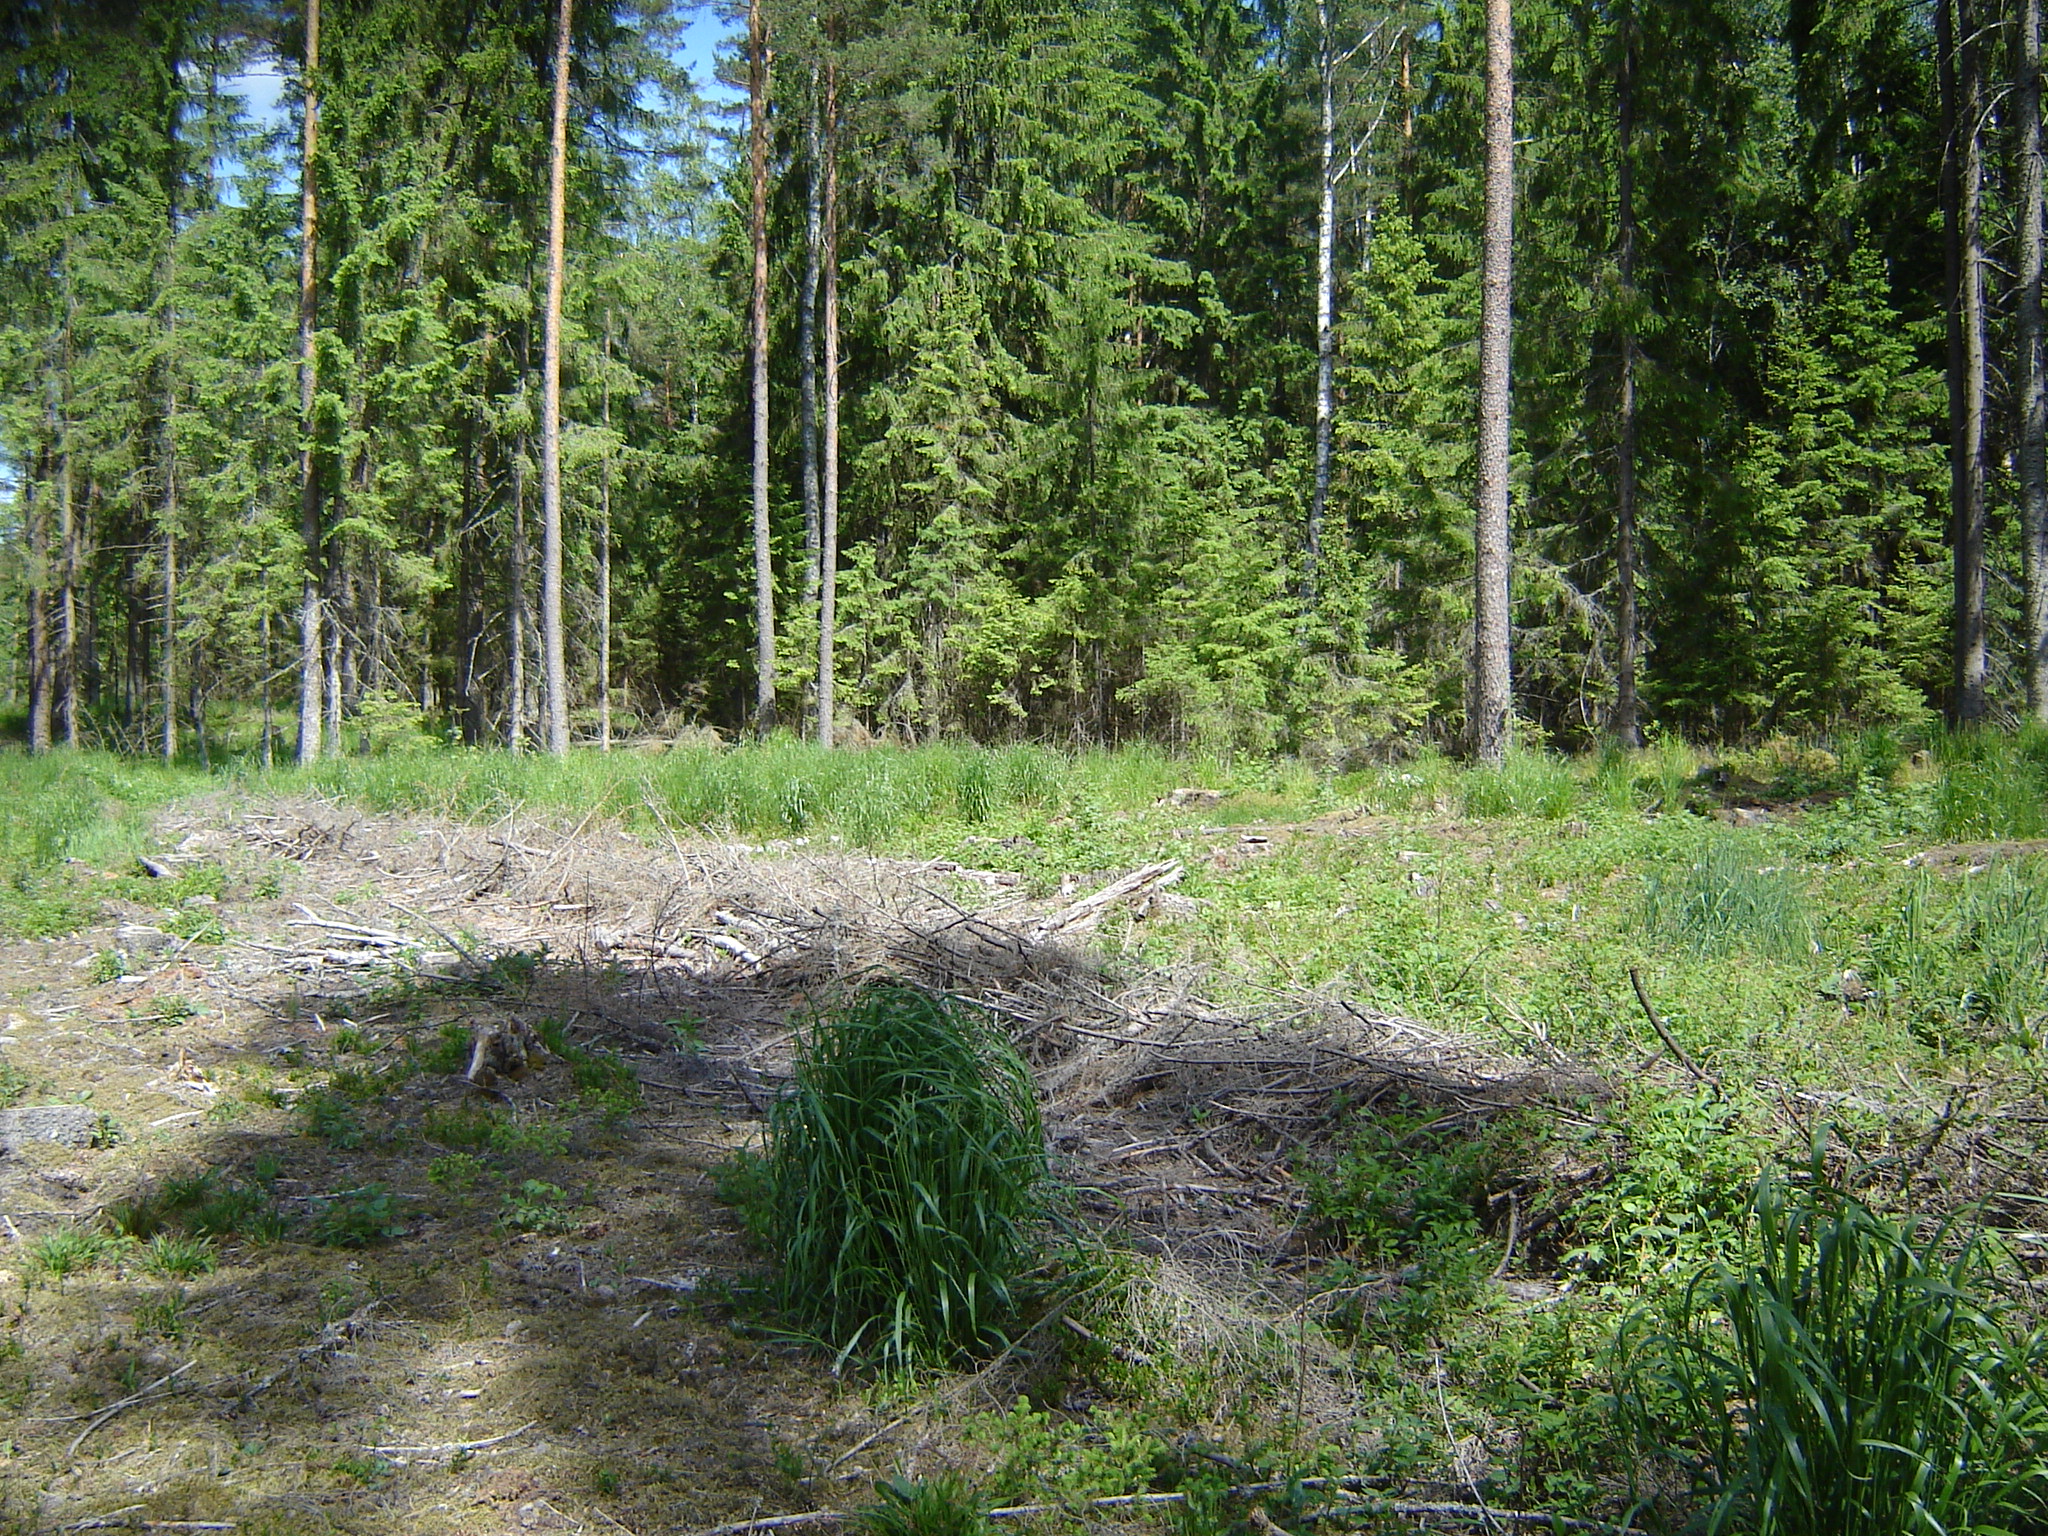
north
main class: Woodland
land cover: Pine dominated coniferous woodland
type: hemiboreal forest and nemoral coniferous forest and mixed broadleaved-coniferous forest
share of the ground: 50 - 75 %
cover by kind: coniferous forest trees 50 %, lichens and mosses 30 %, shrubs 10 %, herbaceous plants 10 %
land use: Forestry
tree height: > 5 m
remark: Clear cut
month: June
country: LT
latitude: 55.6807
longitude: 25.1763
